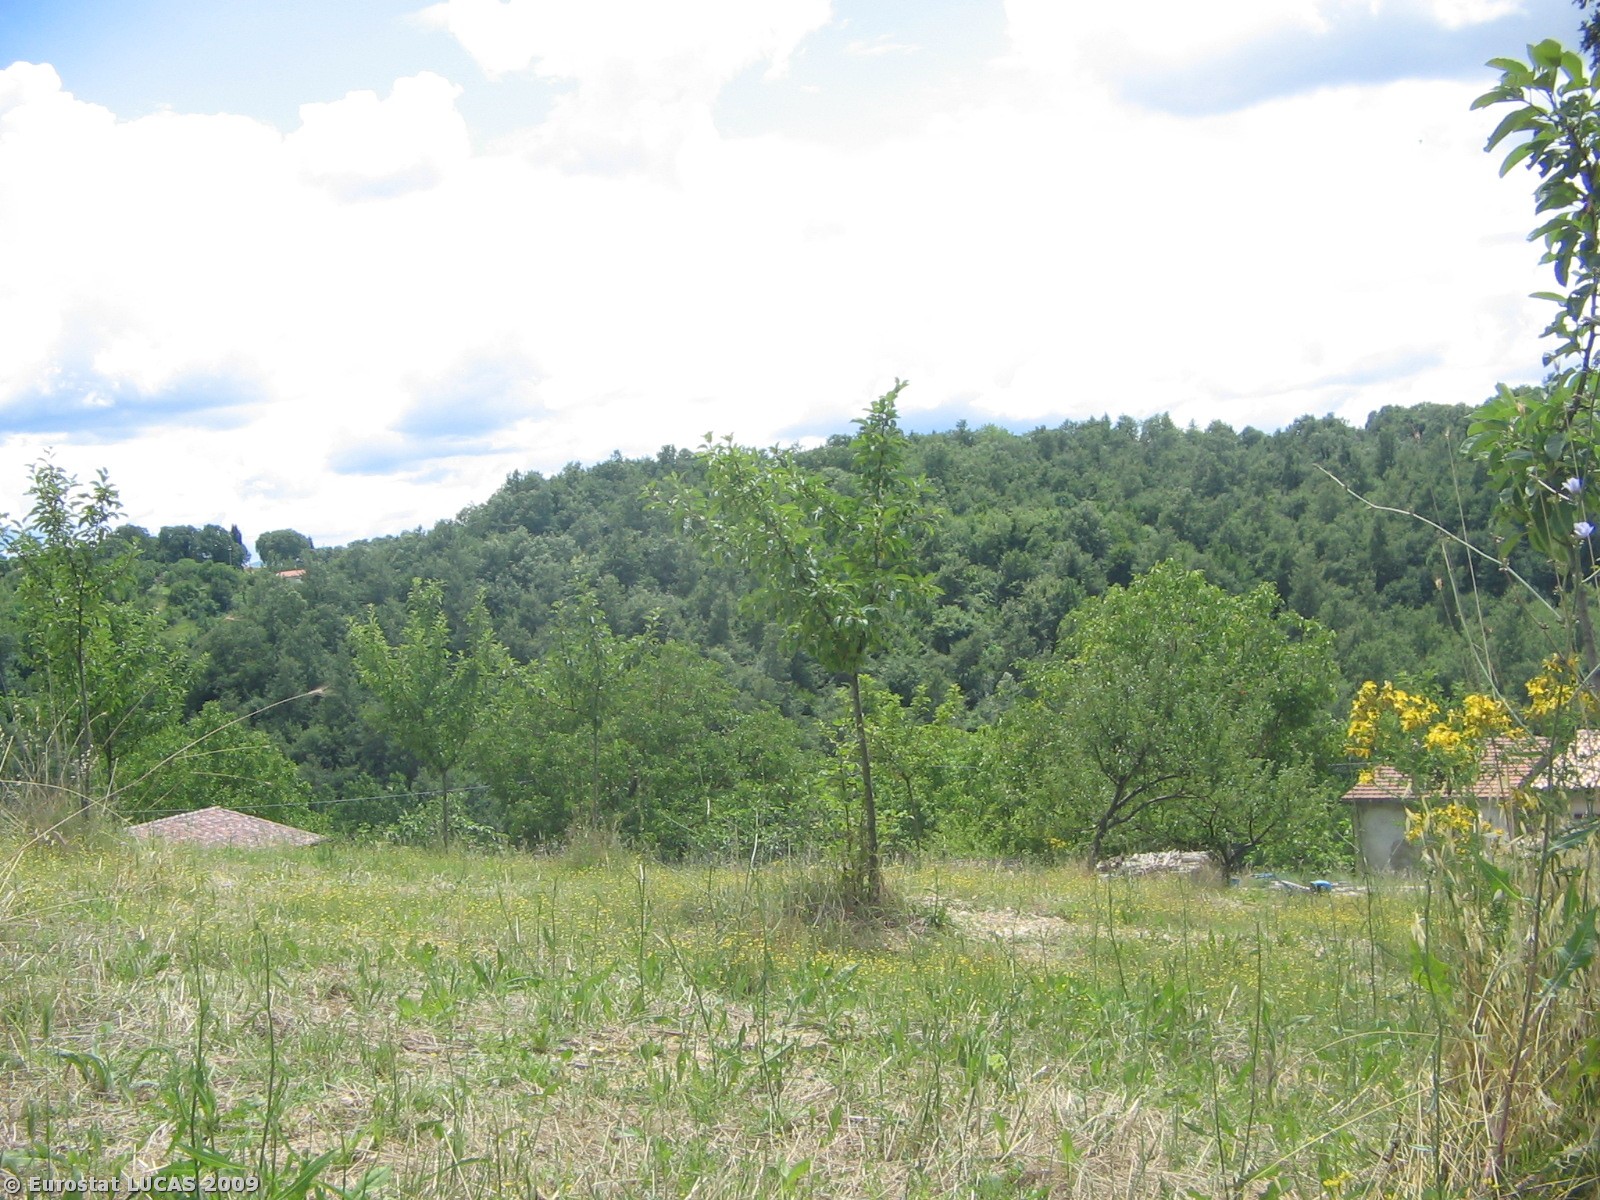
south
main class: Woodland
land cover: Broadleaved woodland
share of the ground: 25 - 50 %
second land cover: Grassland with sparse tree/shrub cover
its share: > 75 %
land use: Forestry
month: June
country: IT
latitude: 42.2702
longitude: 12.8637
